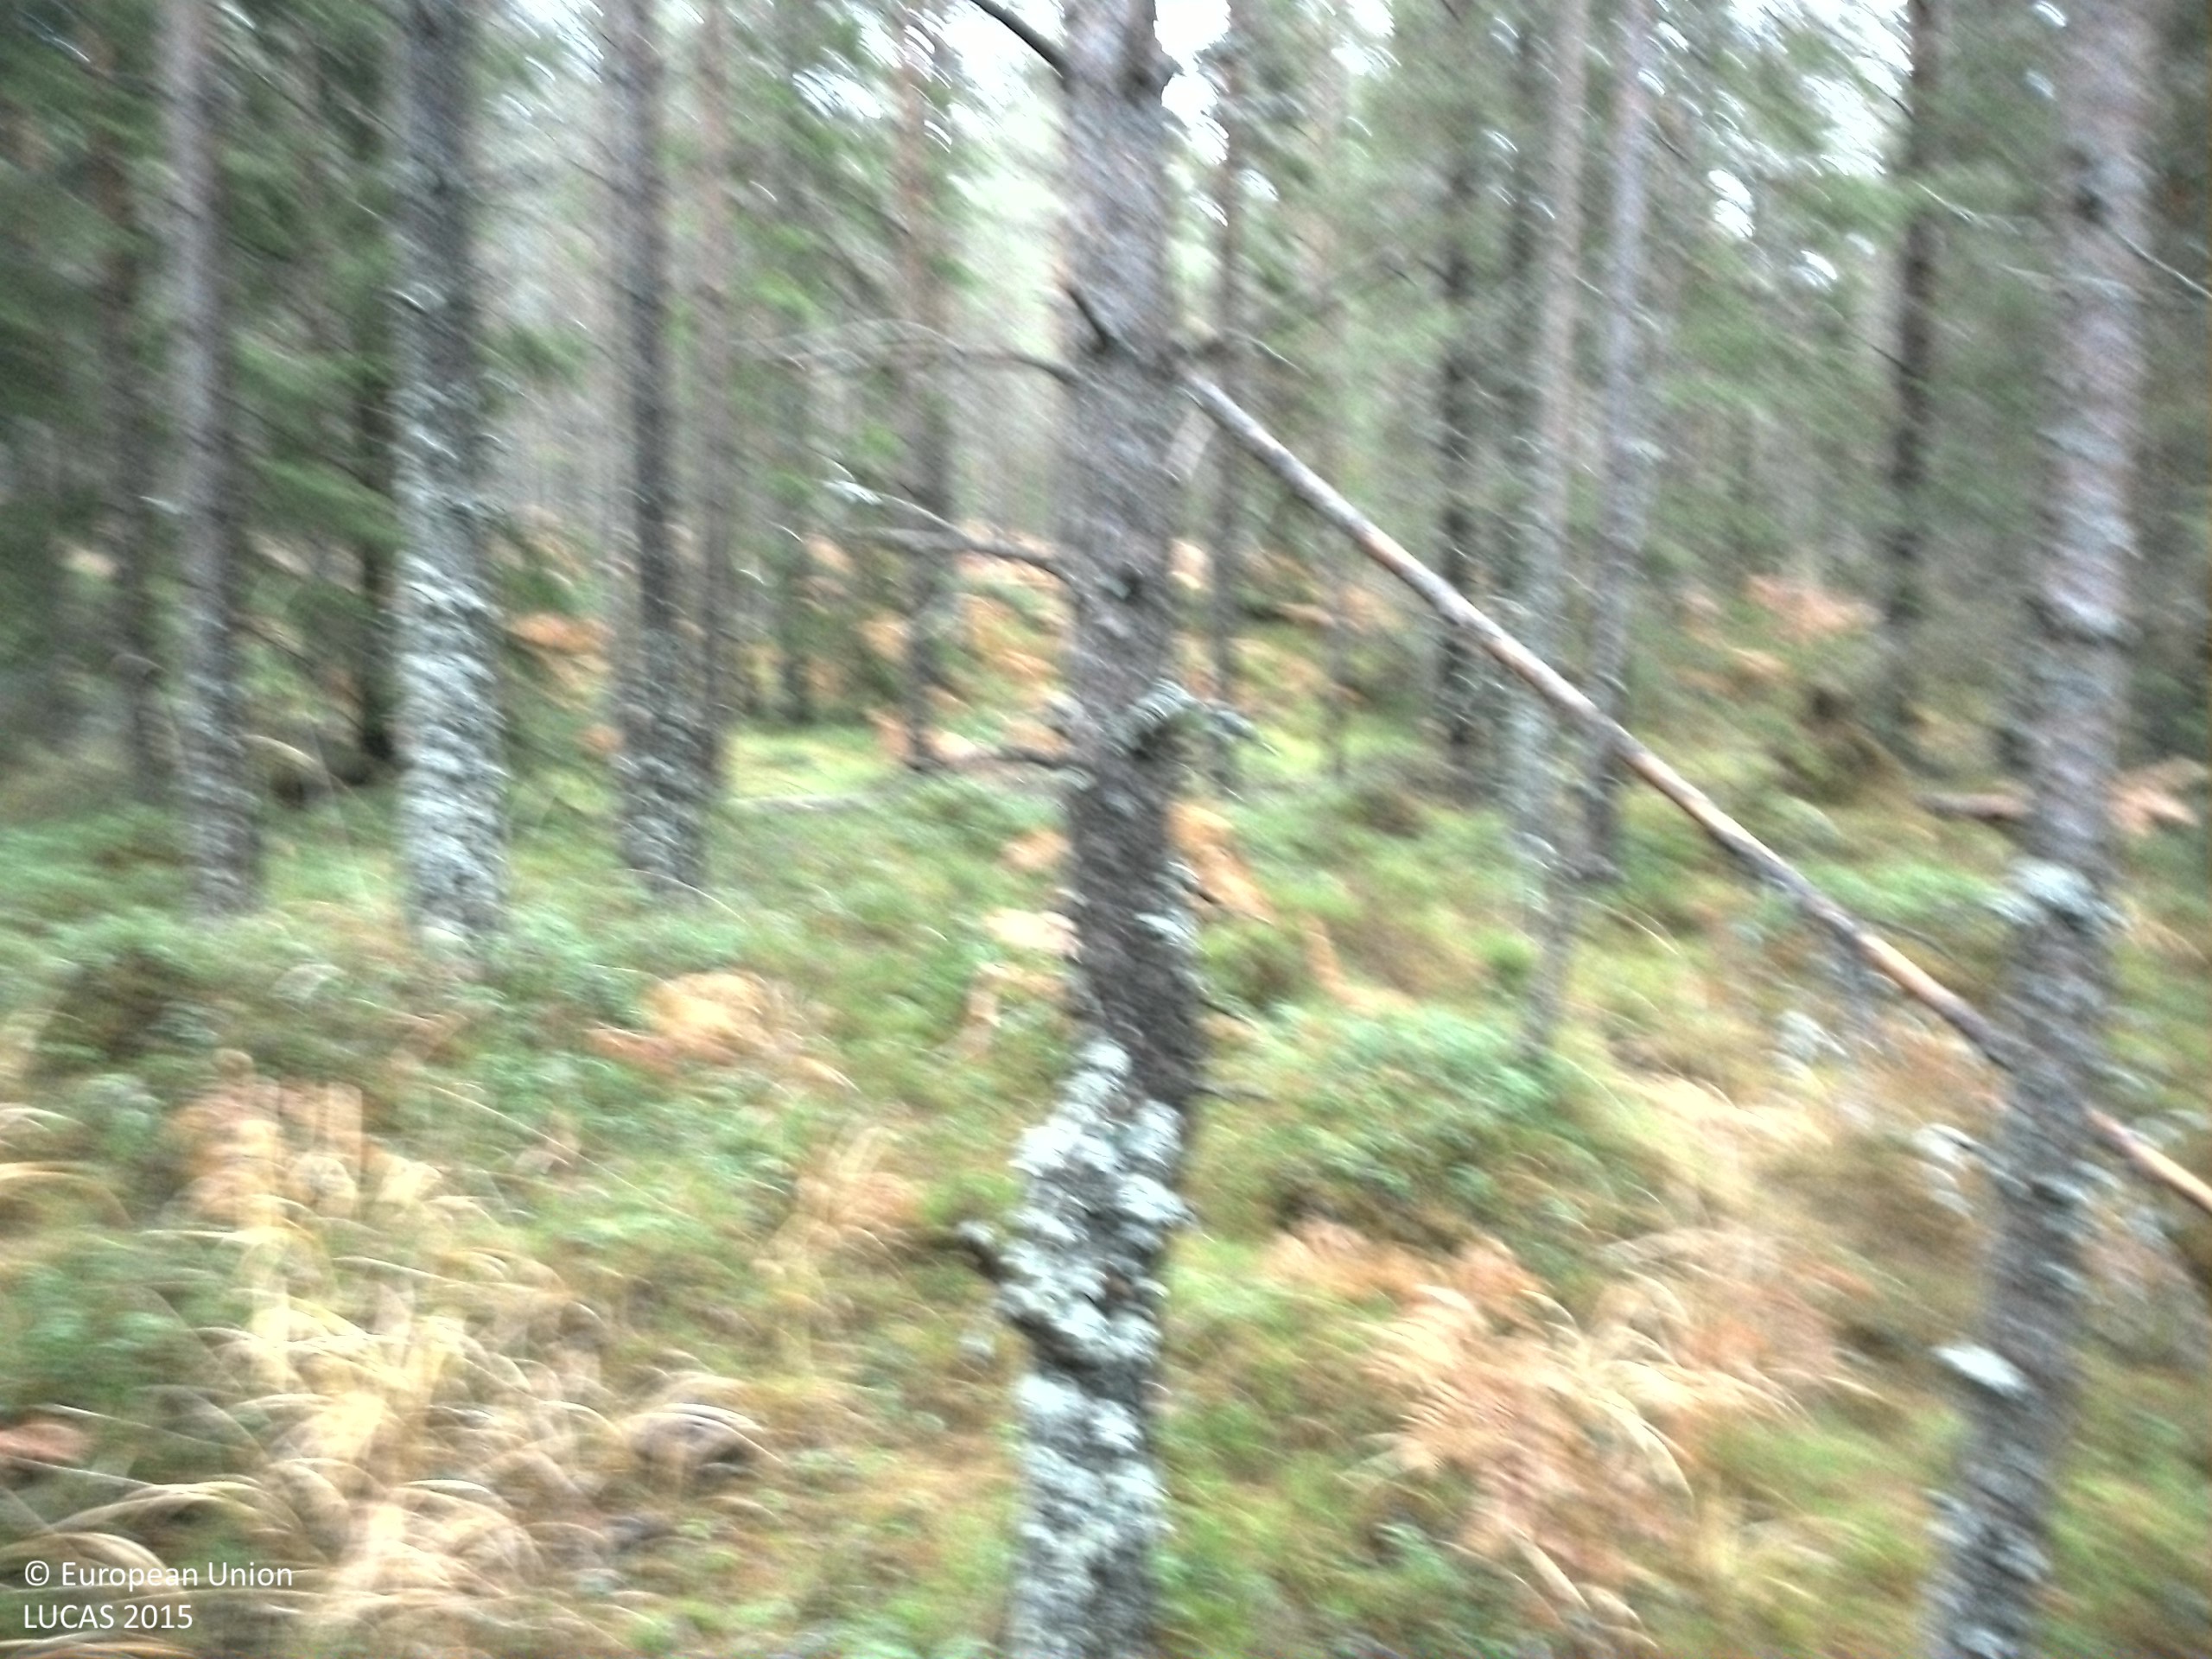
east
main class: Woodland
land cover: Pine dominated coniferous woodland
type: boreal forest
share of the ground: > 75 %
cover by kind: coniferous forest trees 75 %, shrubs 15 %, herbaceous plants 5 %, lichens and mosses 5 %
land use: Forestry
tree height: > 5 m
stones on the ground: 10 - 25 %
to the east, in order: Pine dominated coniferous woodland; Tracks; Other coniferous woodland; Pine dominated coniferous woodland; Other coniferous woodland
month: November
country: SE
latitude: 59.9545
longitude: 15.3075
